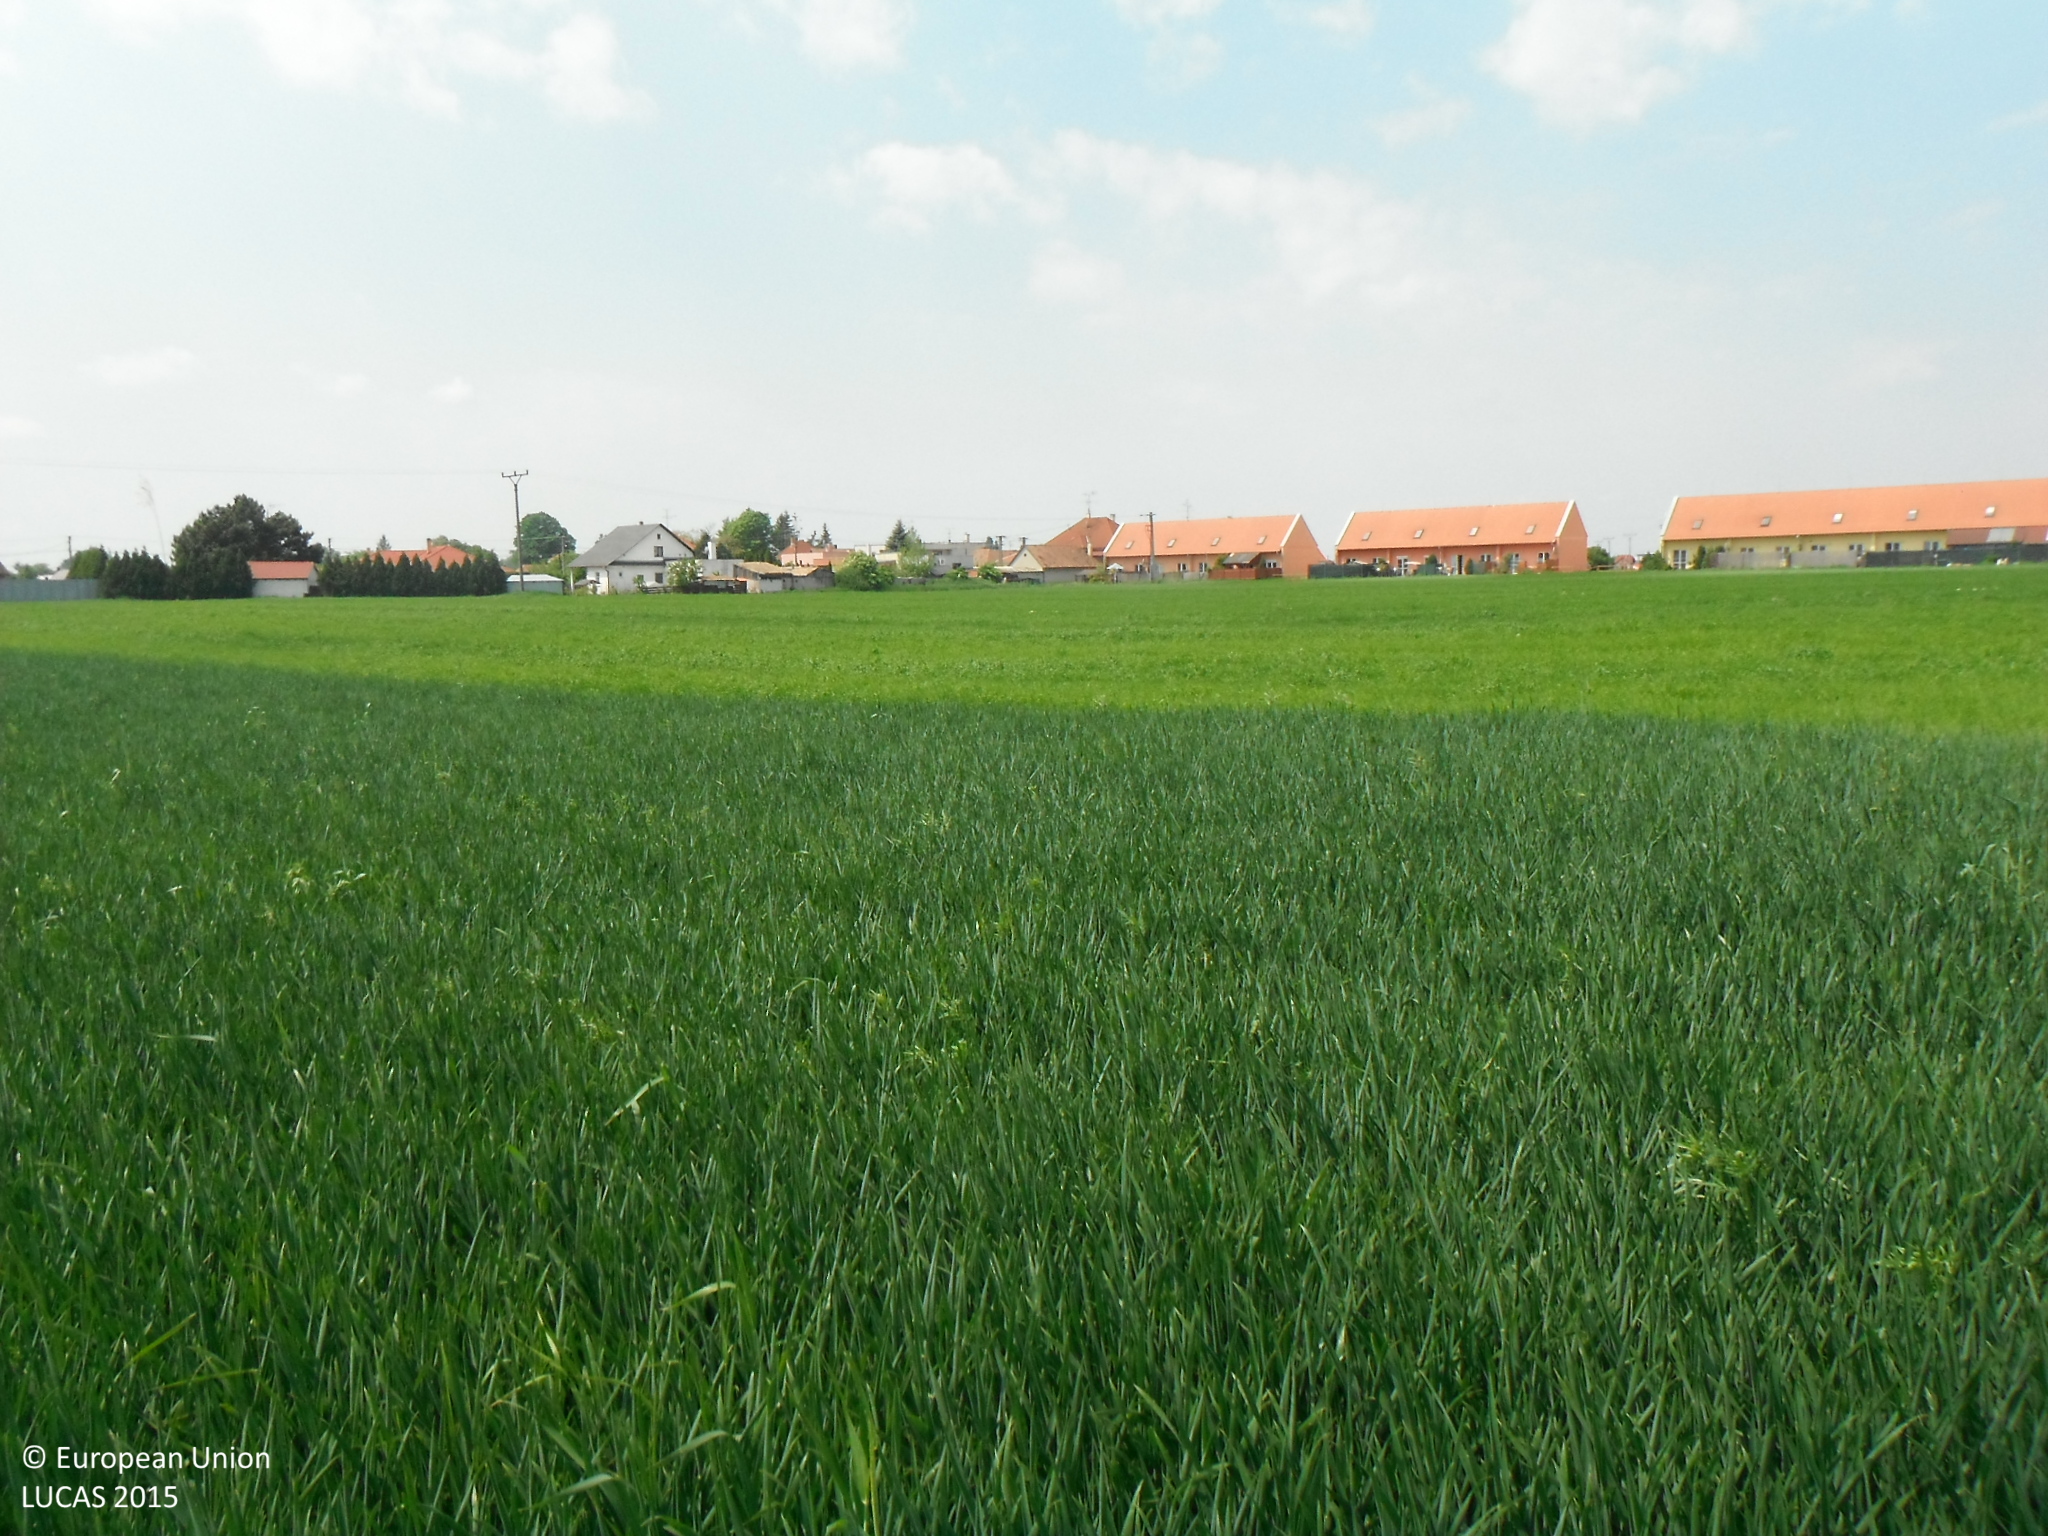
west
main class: Cropland
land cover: Common wheat
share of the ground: > 75 %
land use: Agriculture (excluding fallow land and kitchen gardens)
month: May
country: SK
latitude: 47.9749
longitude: 17.6594
